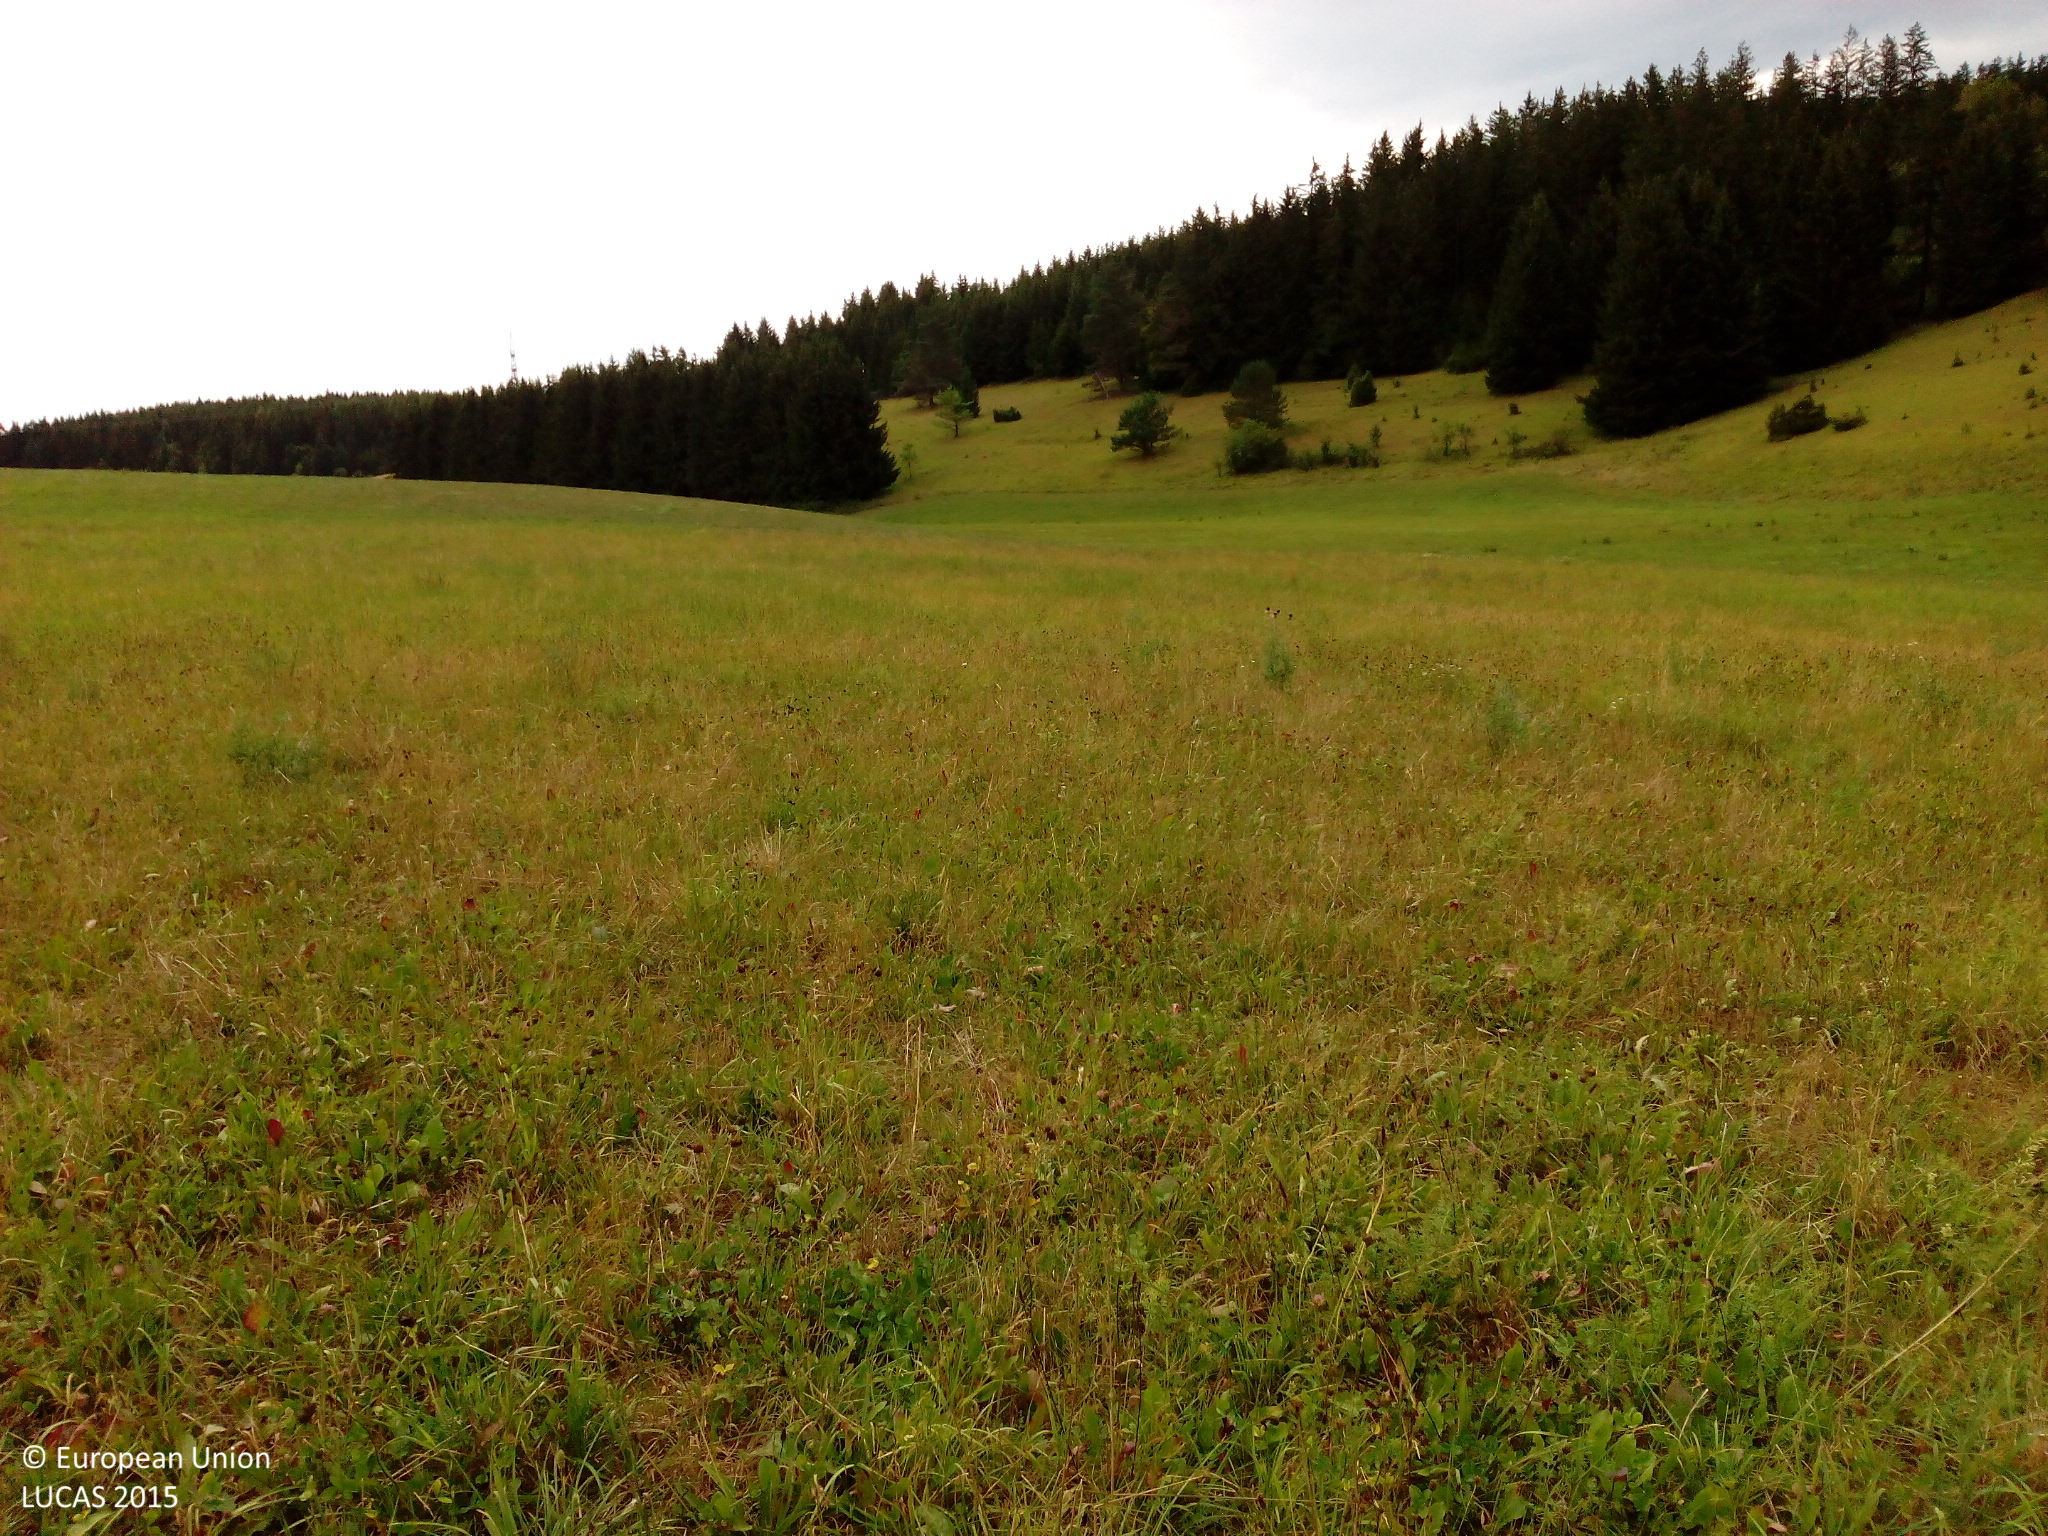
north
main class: Grassland
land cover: Grassland without tree/shrub cover
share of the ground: > 75 %
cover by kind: herbaceous plants 95 %, unconsolidated bare surface 5 %
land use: Agriculture (excluding fallow land and kitchen gardens)
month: August
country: DE
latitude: 48.6194
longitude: 9.9593
